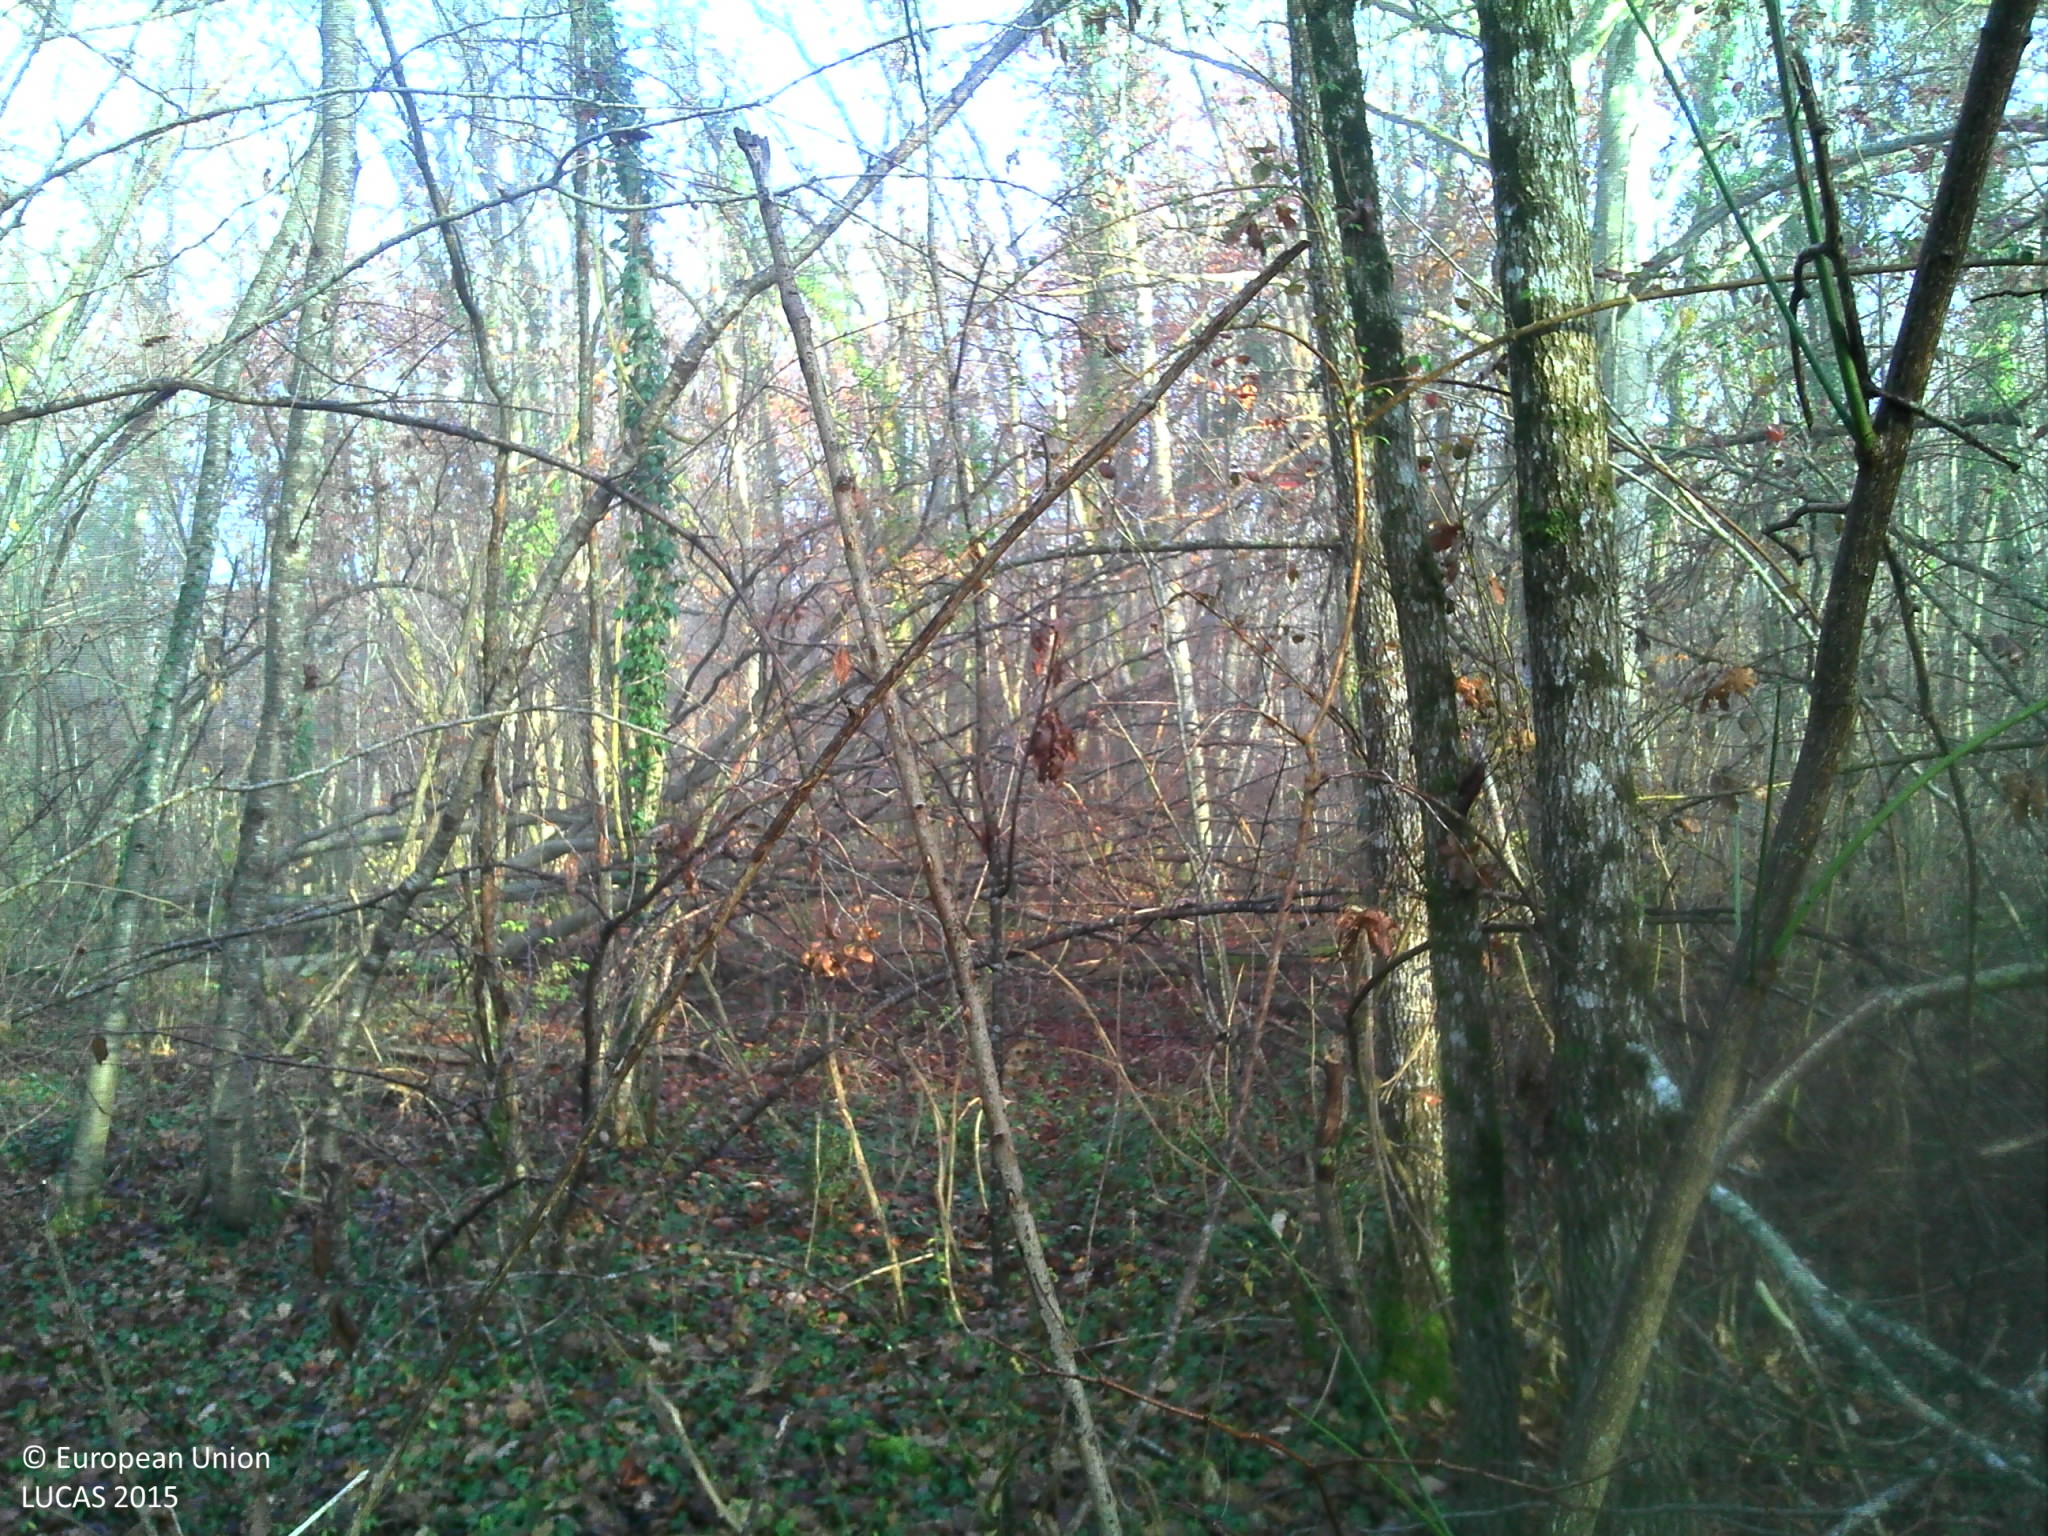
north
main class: Woodland
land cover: Broadleaved woodland
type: mesophytic deciduous forest
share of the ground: > 75 %
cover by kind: broadleaved forest trees 100 %
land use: Forestry
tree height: > 5 m
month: December
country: FR
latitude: 47.4514
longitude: 3.1646
